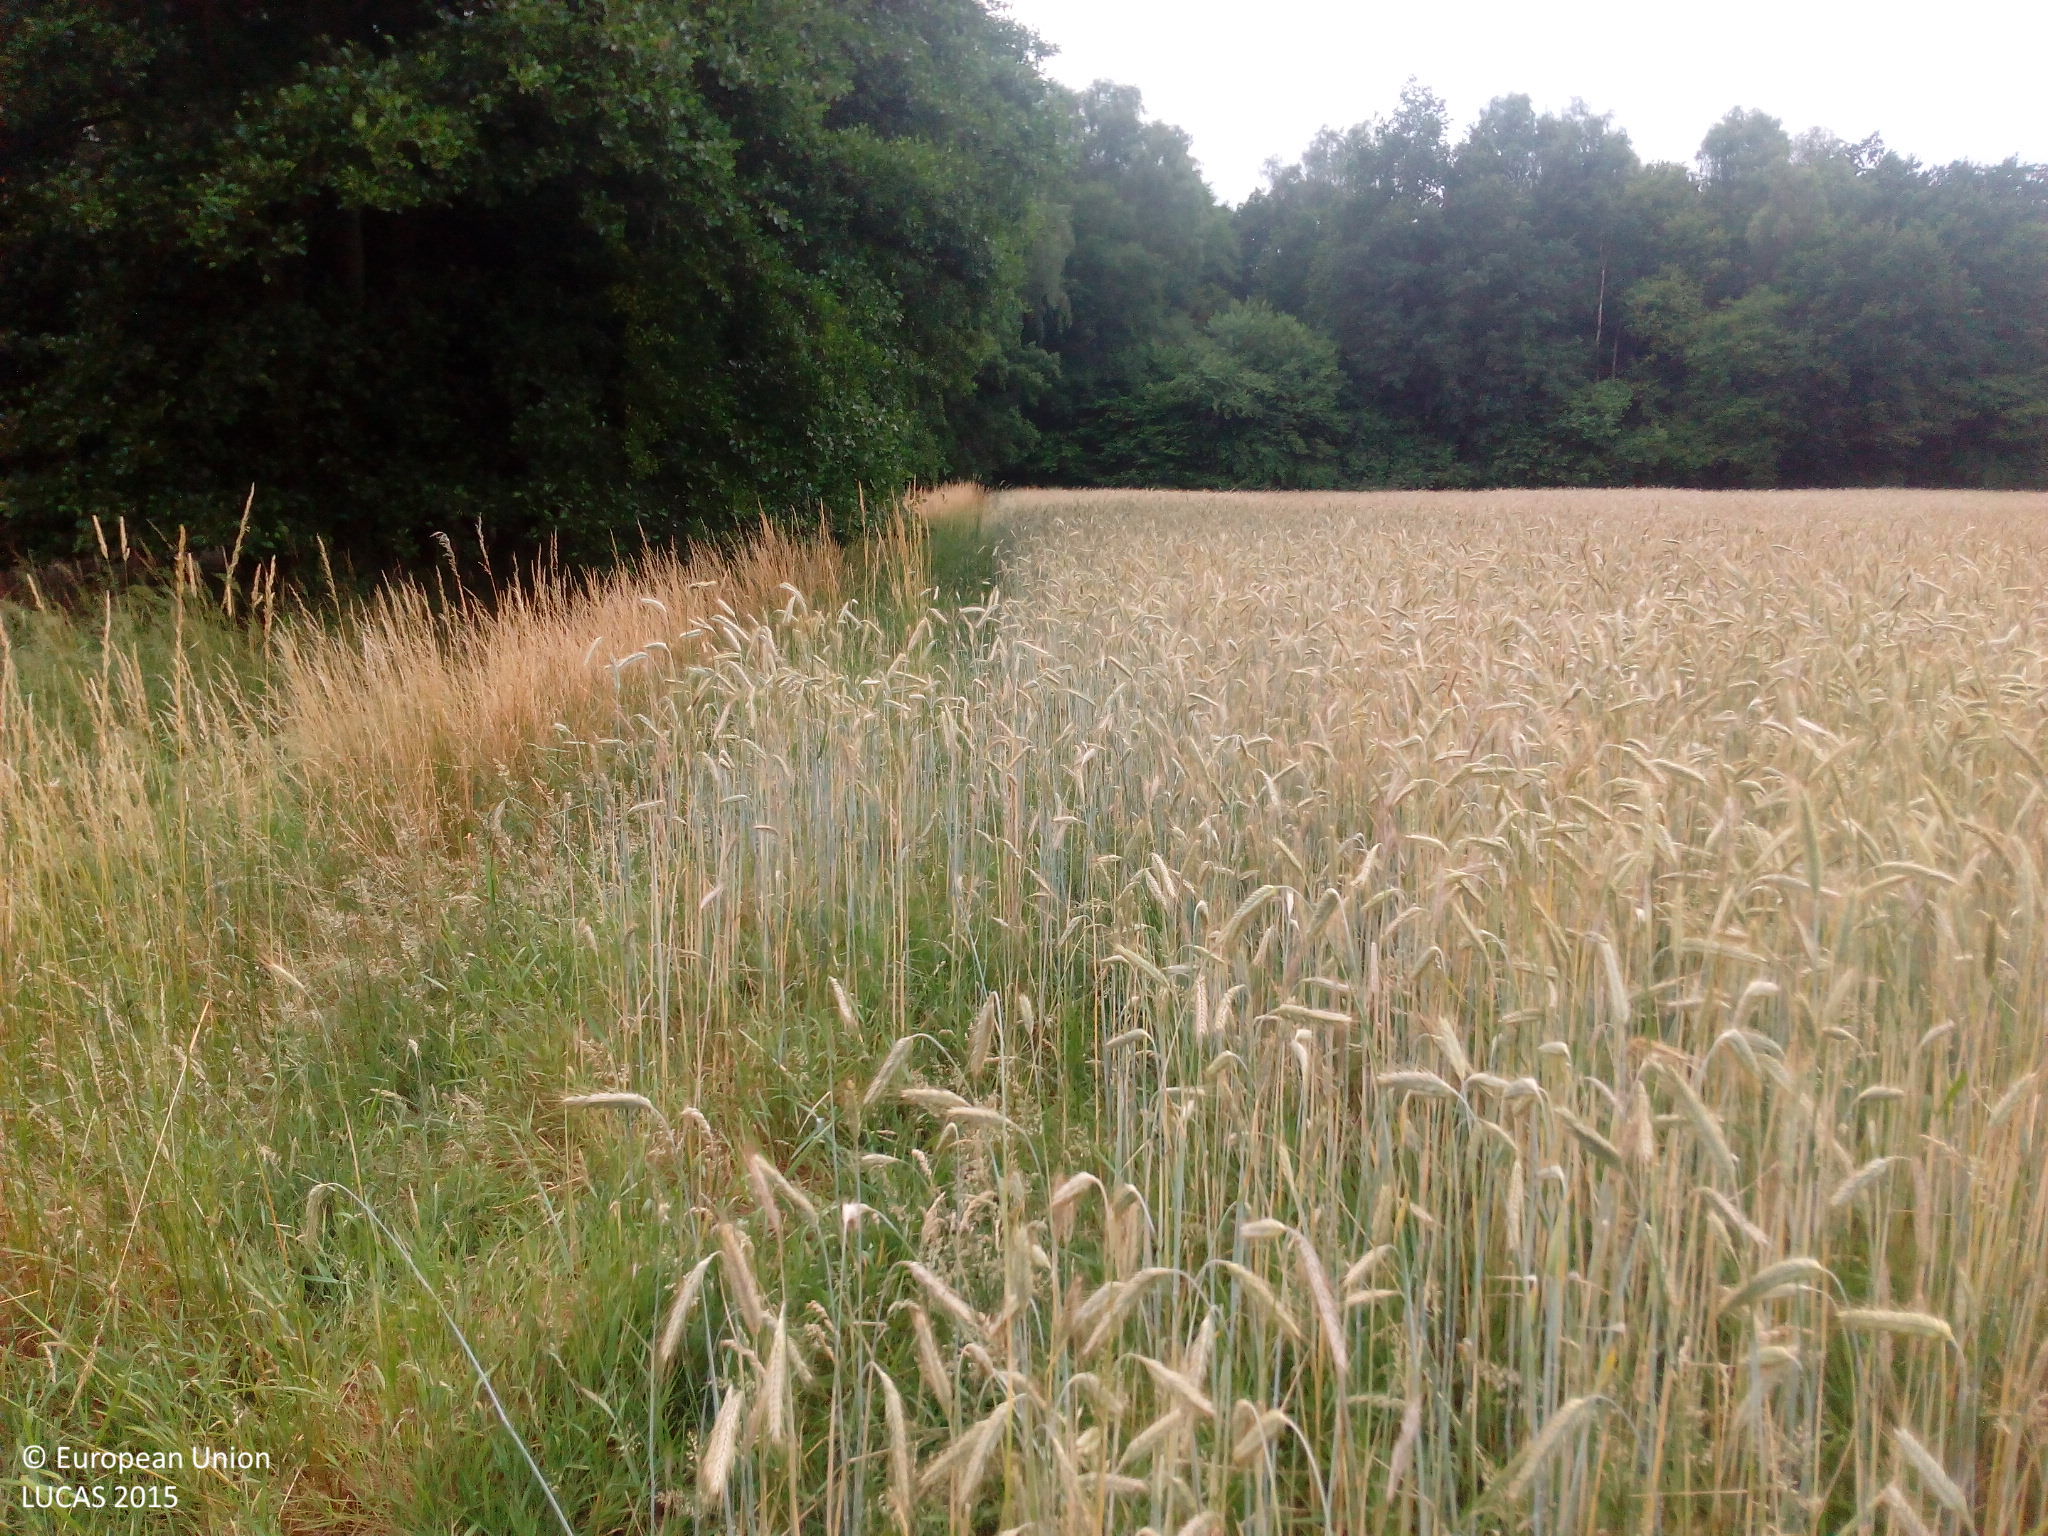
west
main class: Cropland
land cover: Rye
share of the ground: > 75 %
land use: Agriculture (excluding fallow land and kitchen gardens)
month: July
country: DE
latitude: 52.8922
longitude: 12.4222
